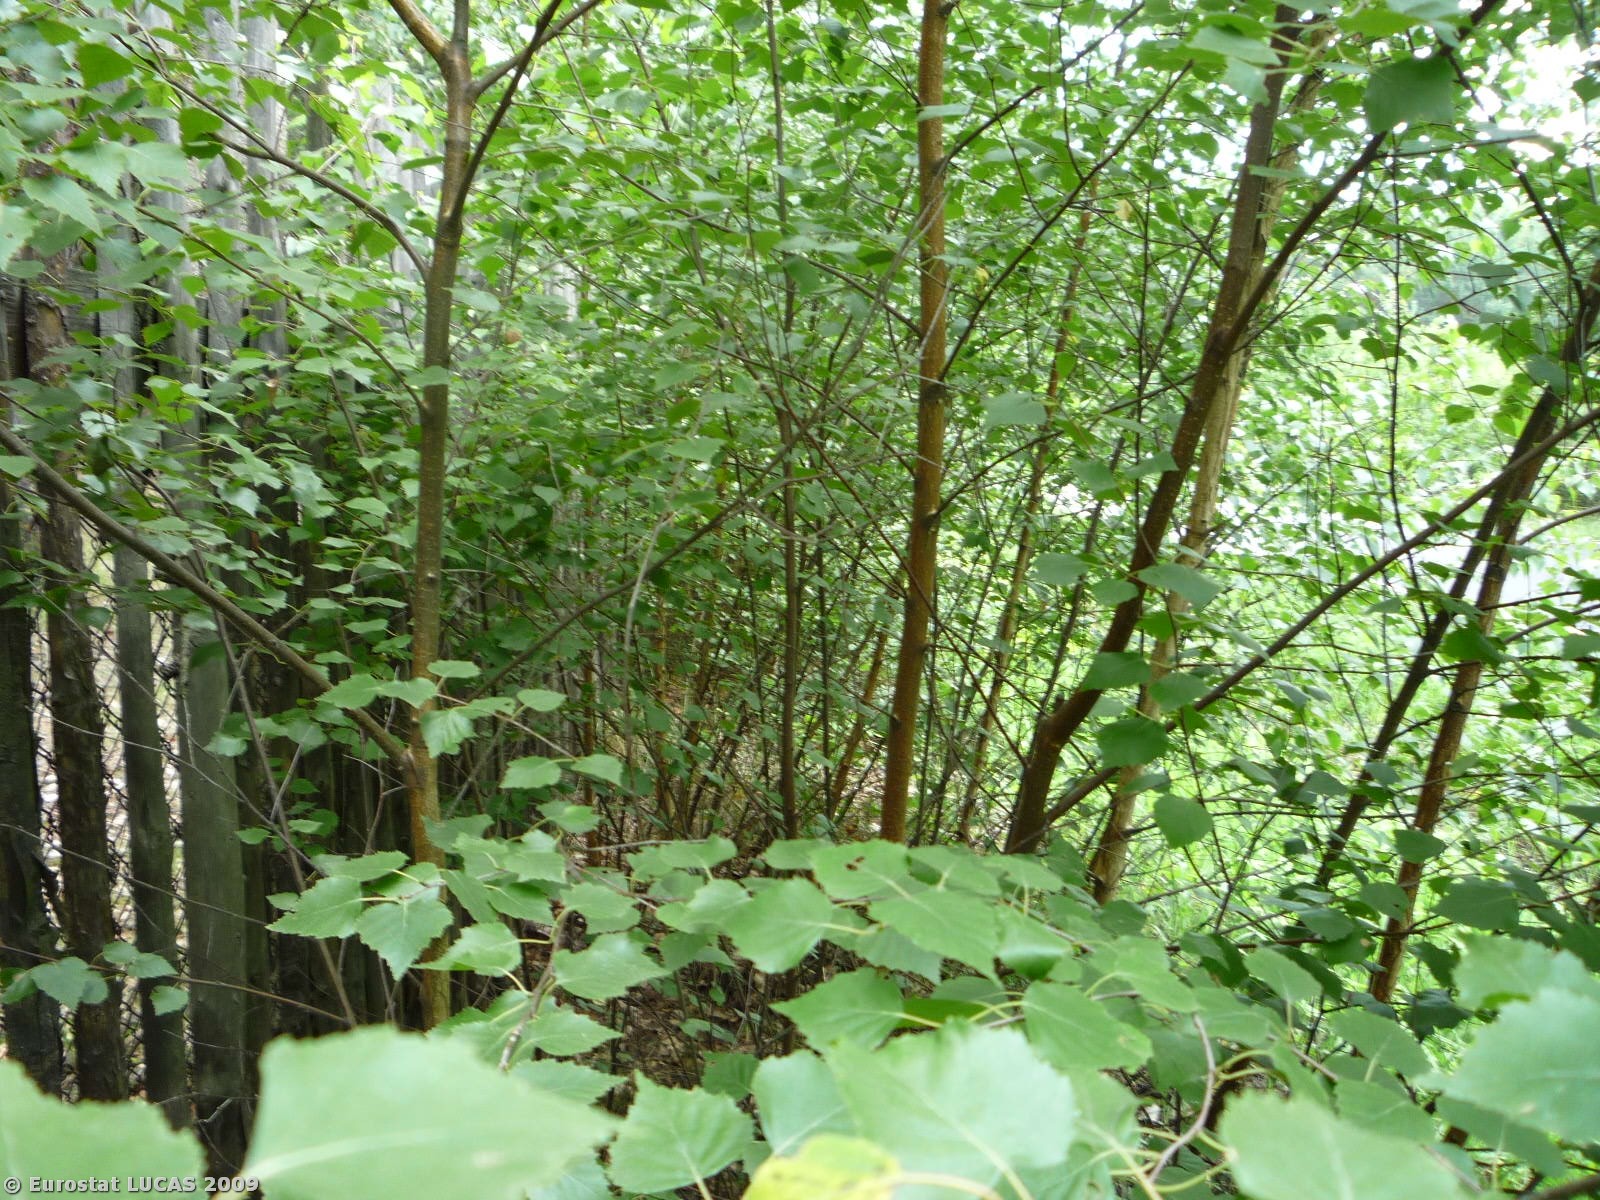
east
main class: Woodland
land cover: Mixed woodland
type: hemiboreal forest and nemoral coniferous forest and mixed broadleaved-coniferous forest
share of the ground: > 75 %
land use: Forestry
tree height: > 5 m
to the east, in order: Mixed woodland; Tracks; Broadleaved woodland
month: June
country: CZ
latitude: 50.3069
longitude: 15.0436
